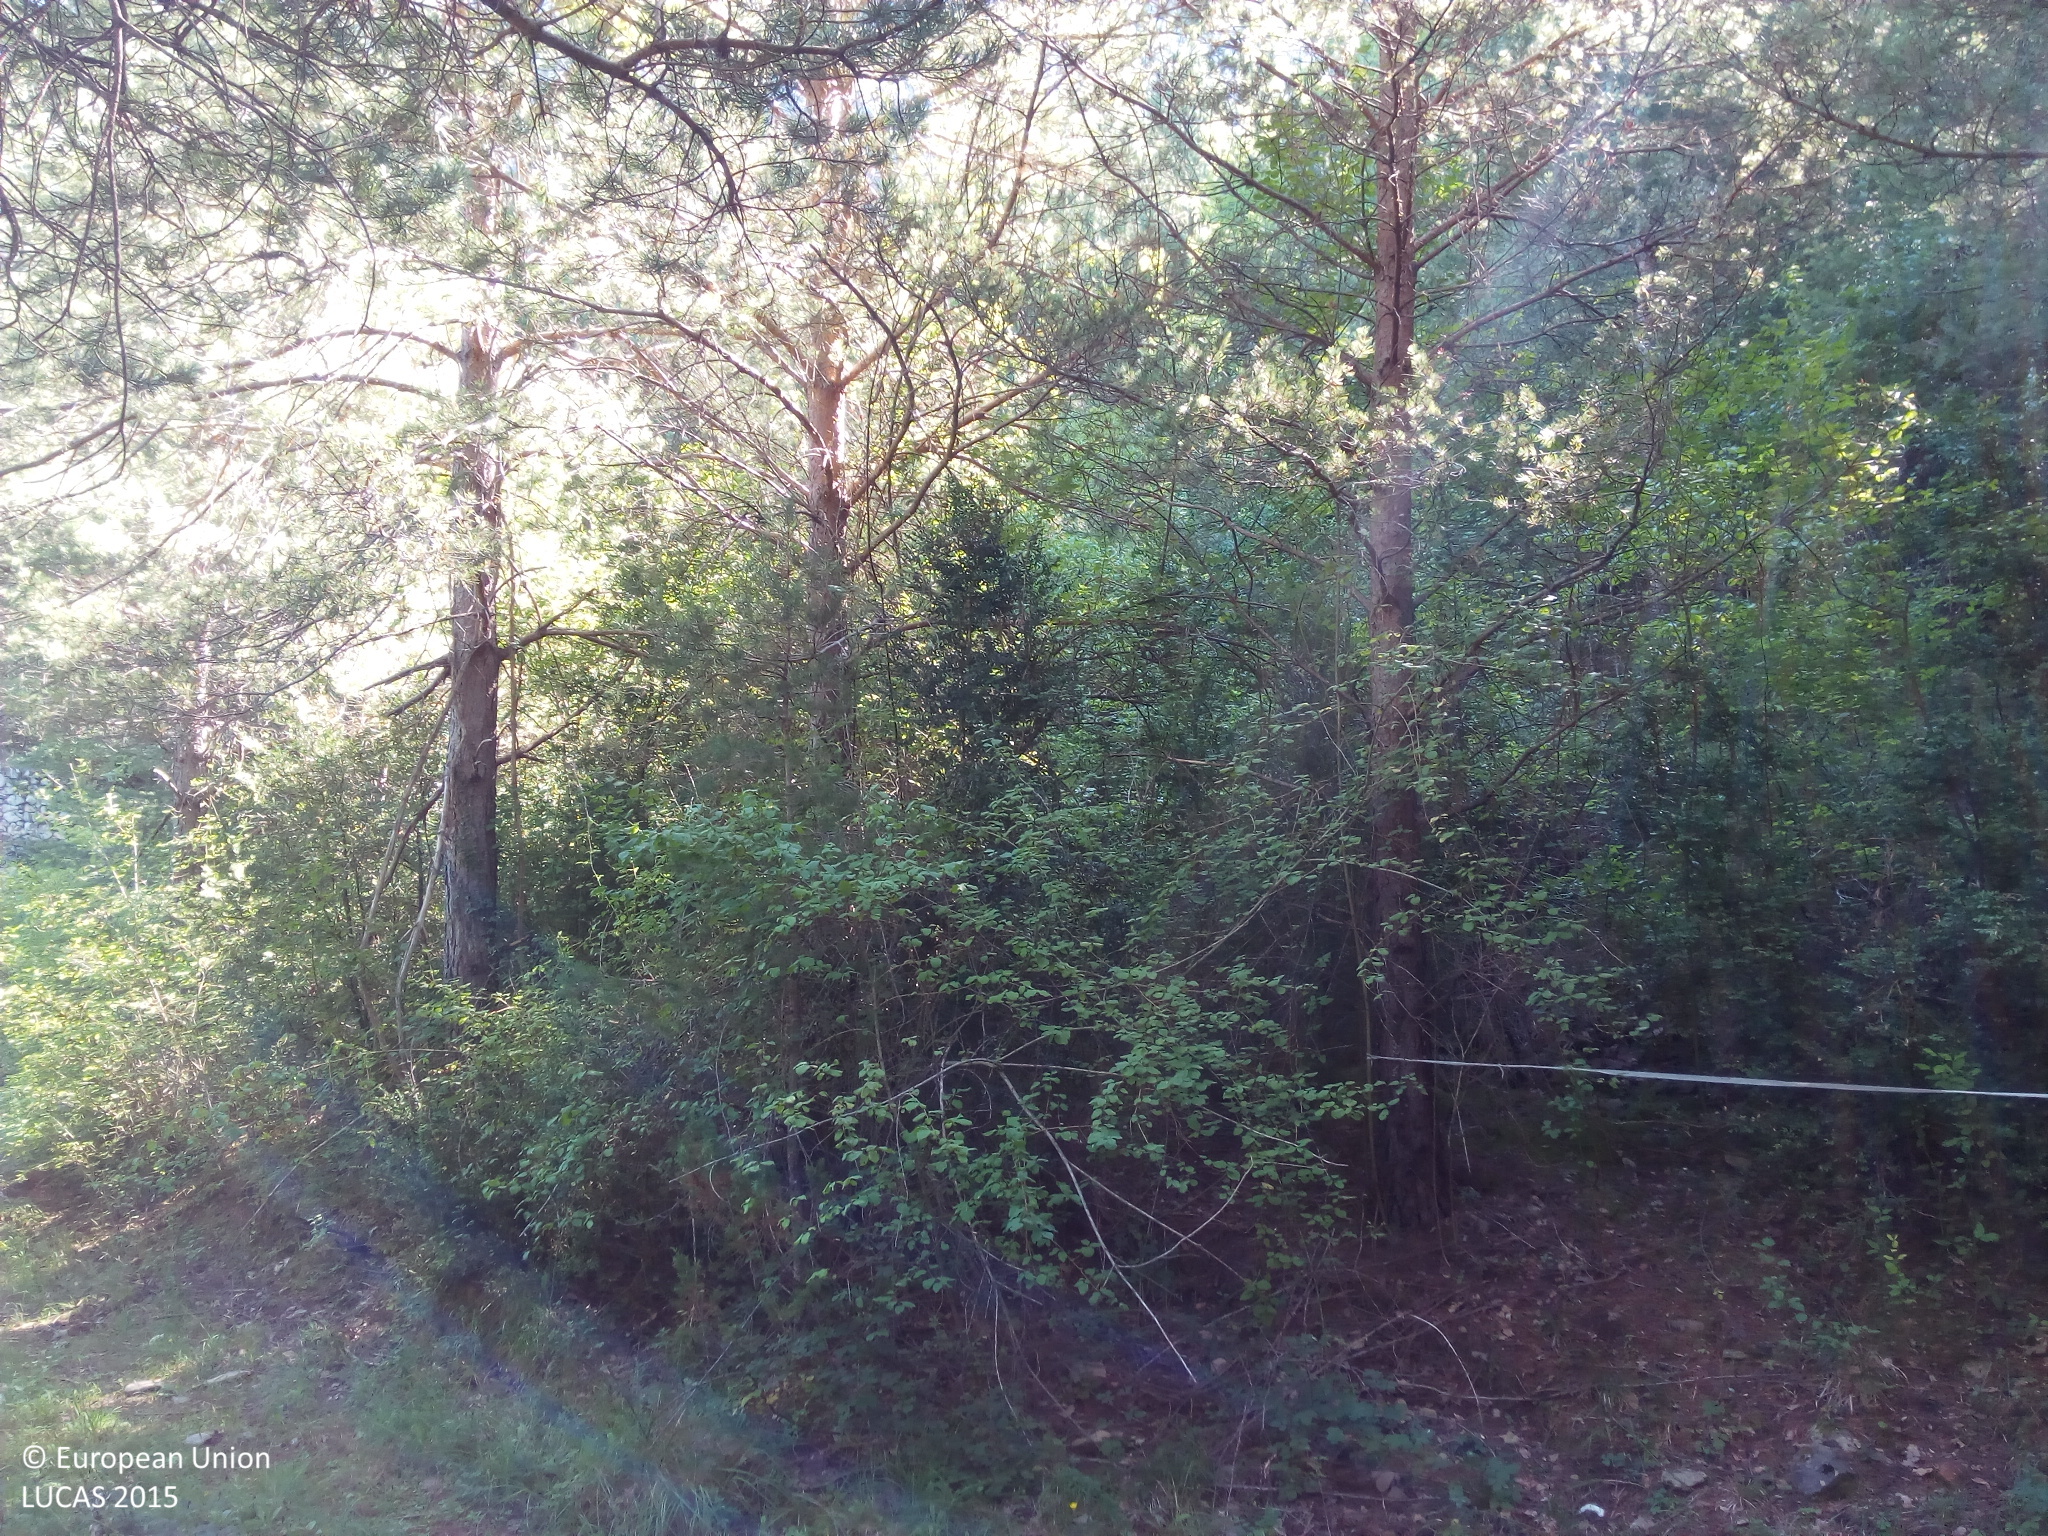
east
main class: Woodland
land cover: Pine dominated mixed woodland
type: coniferous forest of the mediterranean region
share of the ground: > 75 %
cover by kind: coniferous forest trees 75 %, broadleaved forest trees 25 %
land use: Forestry
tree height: > 5 m
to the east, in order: Pine dominated mixed woodland; Tracks; Pine dominated mixed woodland; Tracks; Pine dominated mixed woodland
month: August
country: ES
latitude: 42.5413
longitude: 0.2005
